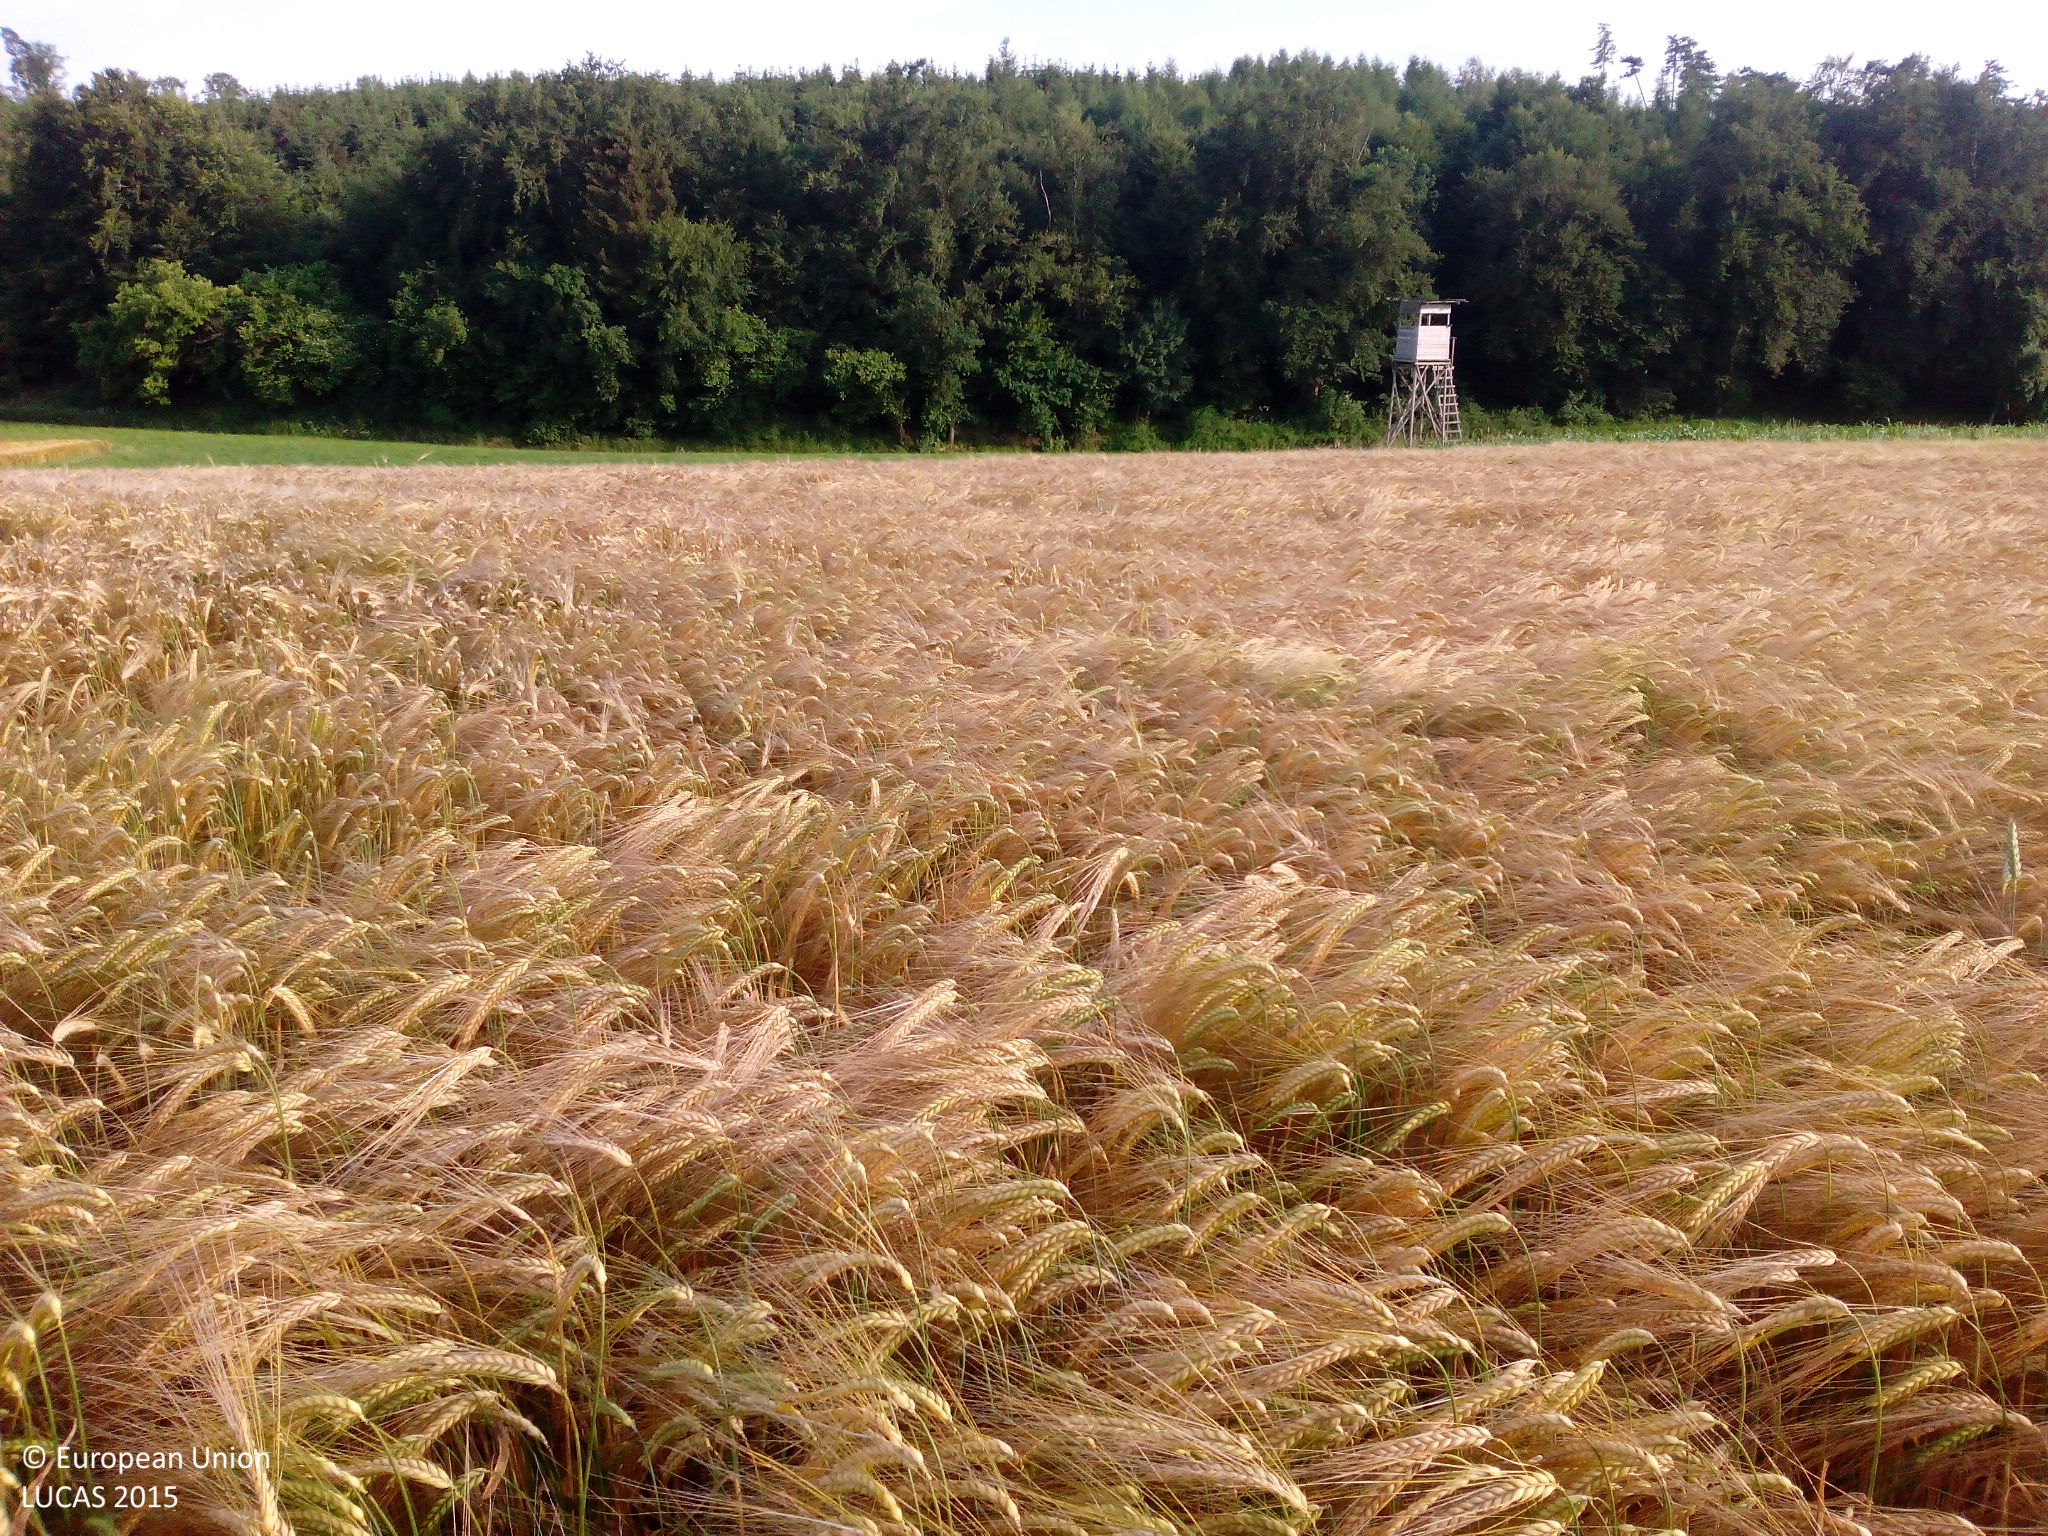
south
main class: Cropland
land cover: Barley
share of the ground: > 75 %
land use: Agriculture (excluding fallow land and kitchen gardens)
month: June
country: DE
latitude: 48.7435
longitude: 10.6388
